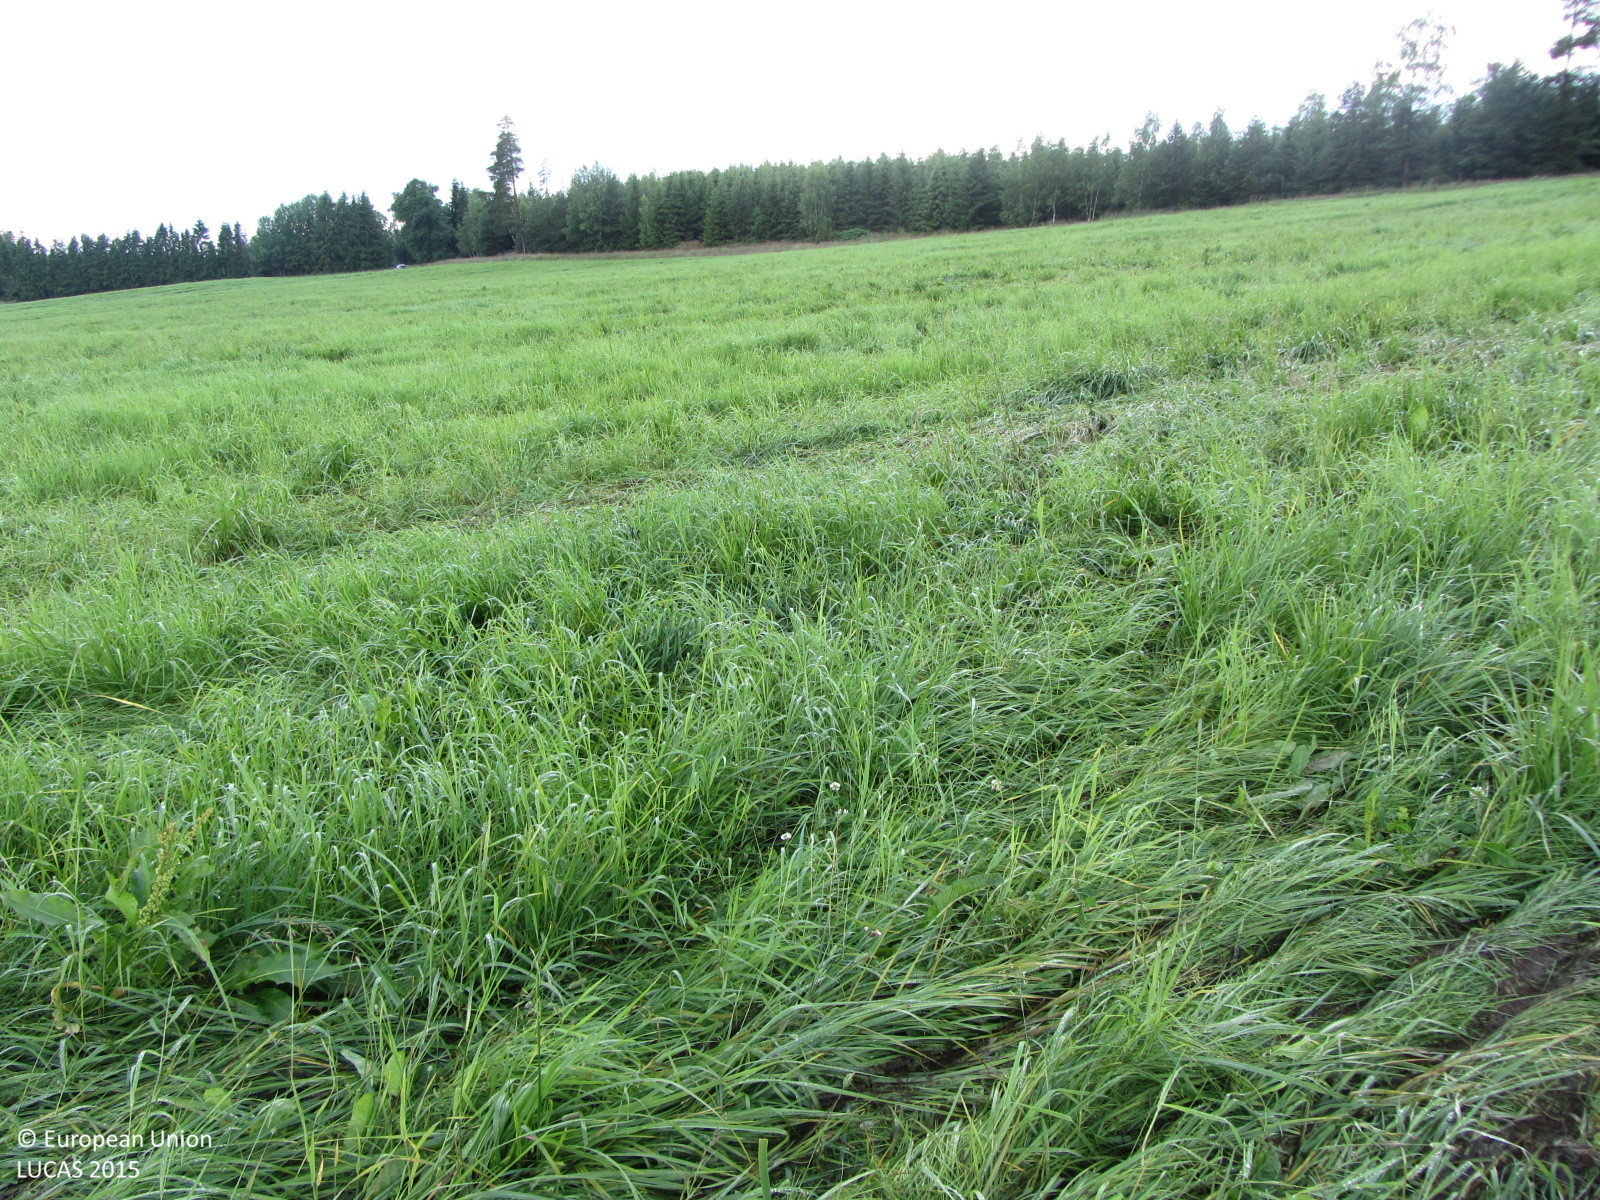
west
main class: Grassland
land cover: Grassland without tree/shrub cover
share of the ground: > 75 %
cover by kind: herbaceous plants 100 %
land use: Agriculture (excluding fallow land and kitchen gardens)
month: July
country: FI
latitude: 60.0495
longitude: 23.2111
